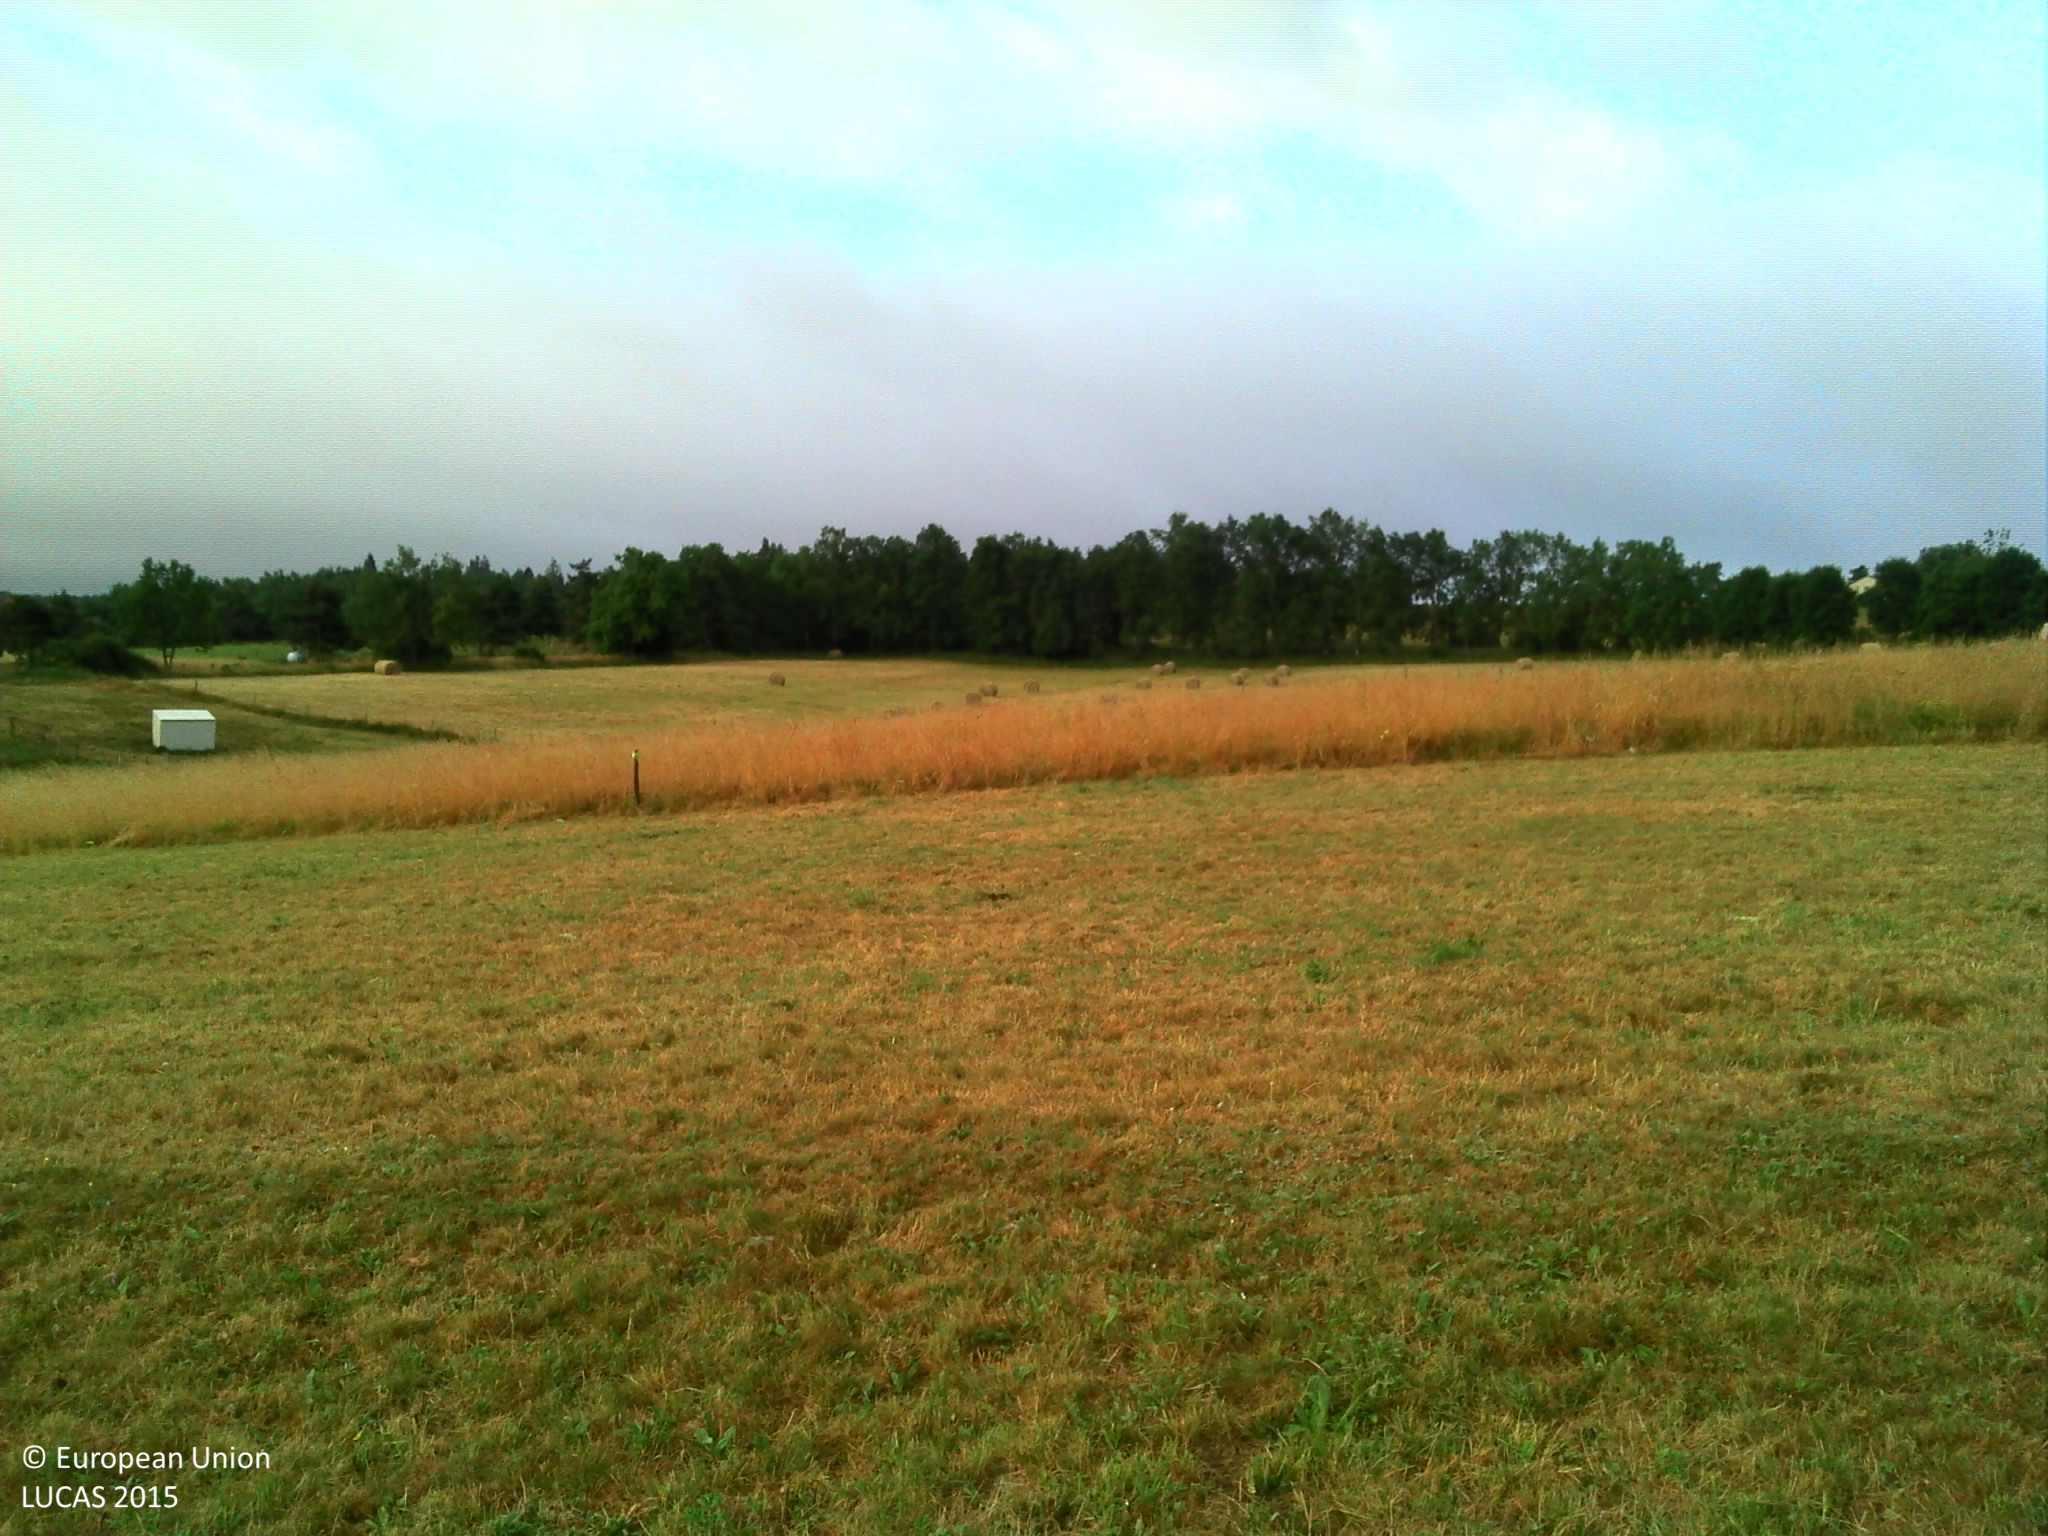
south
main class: Grassland
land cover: Grassland without tree/shrub cover
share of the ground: > 75 %
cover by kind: herbaceous plants 100 %
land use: Agriculture (excluding fallow land and kitchen gardens)
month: July
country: FR
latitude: 45.0686
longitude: 3.2074
